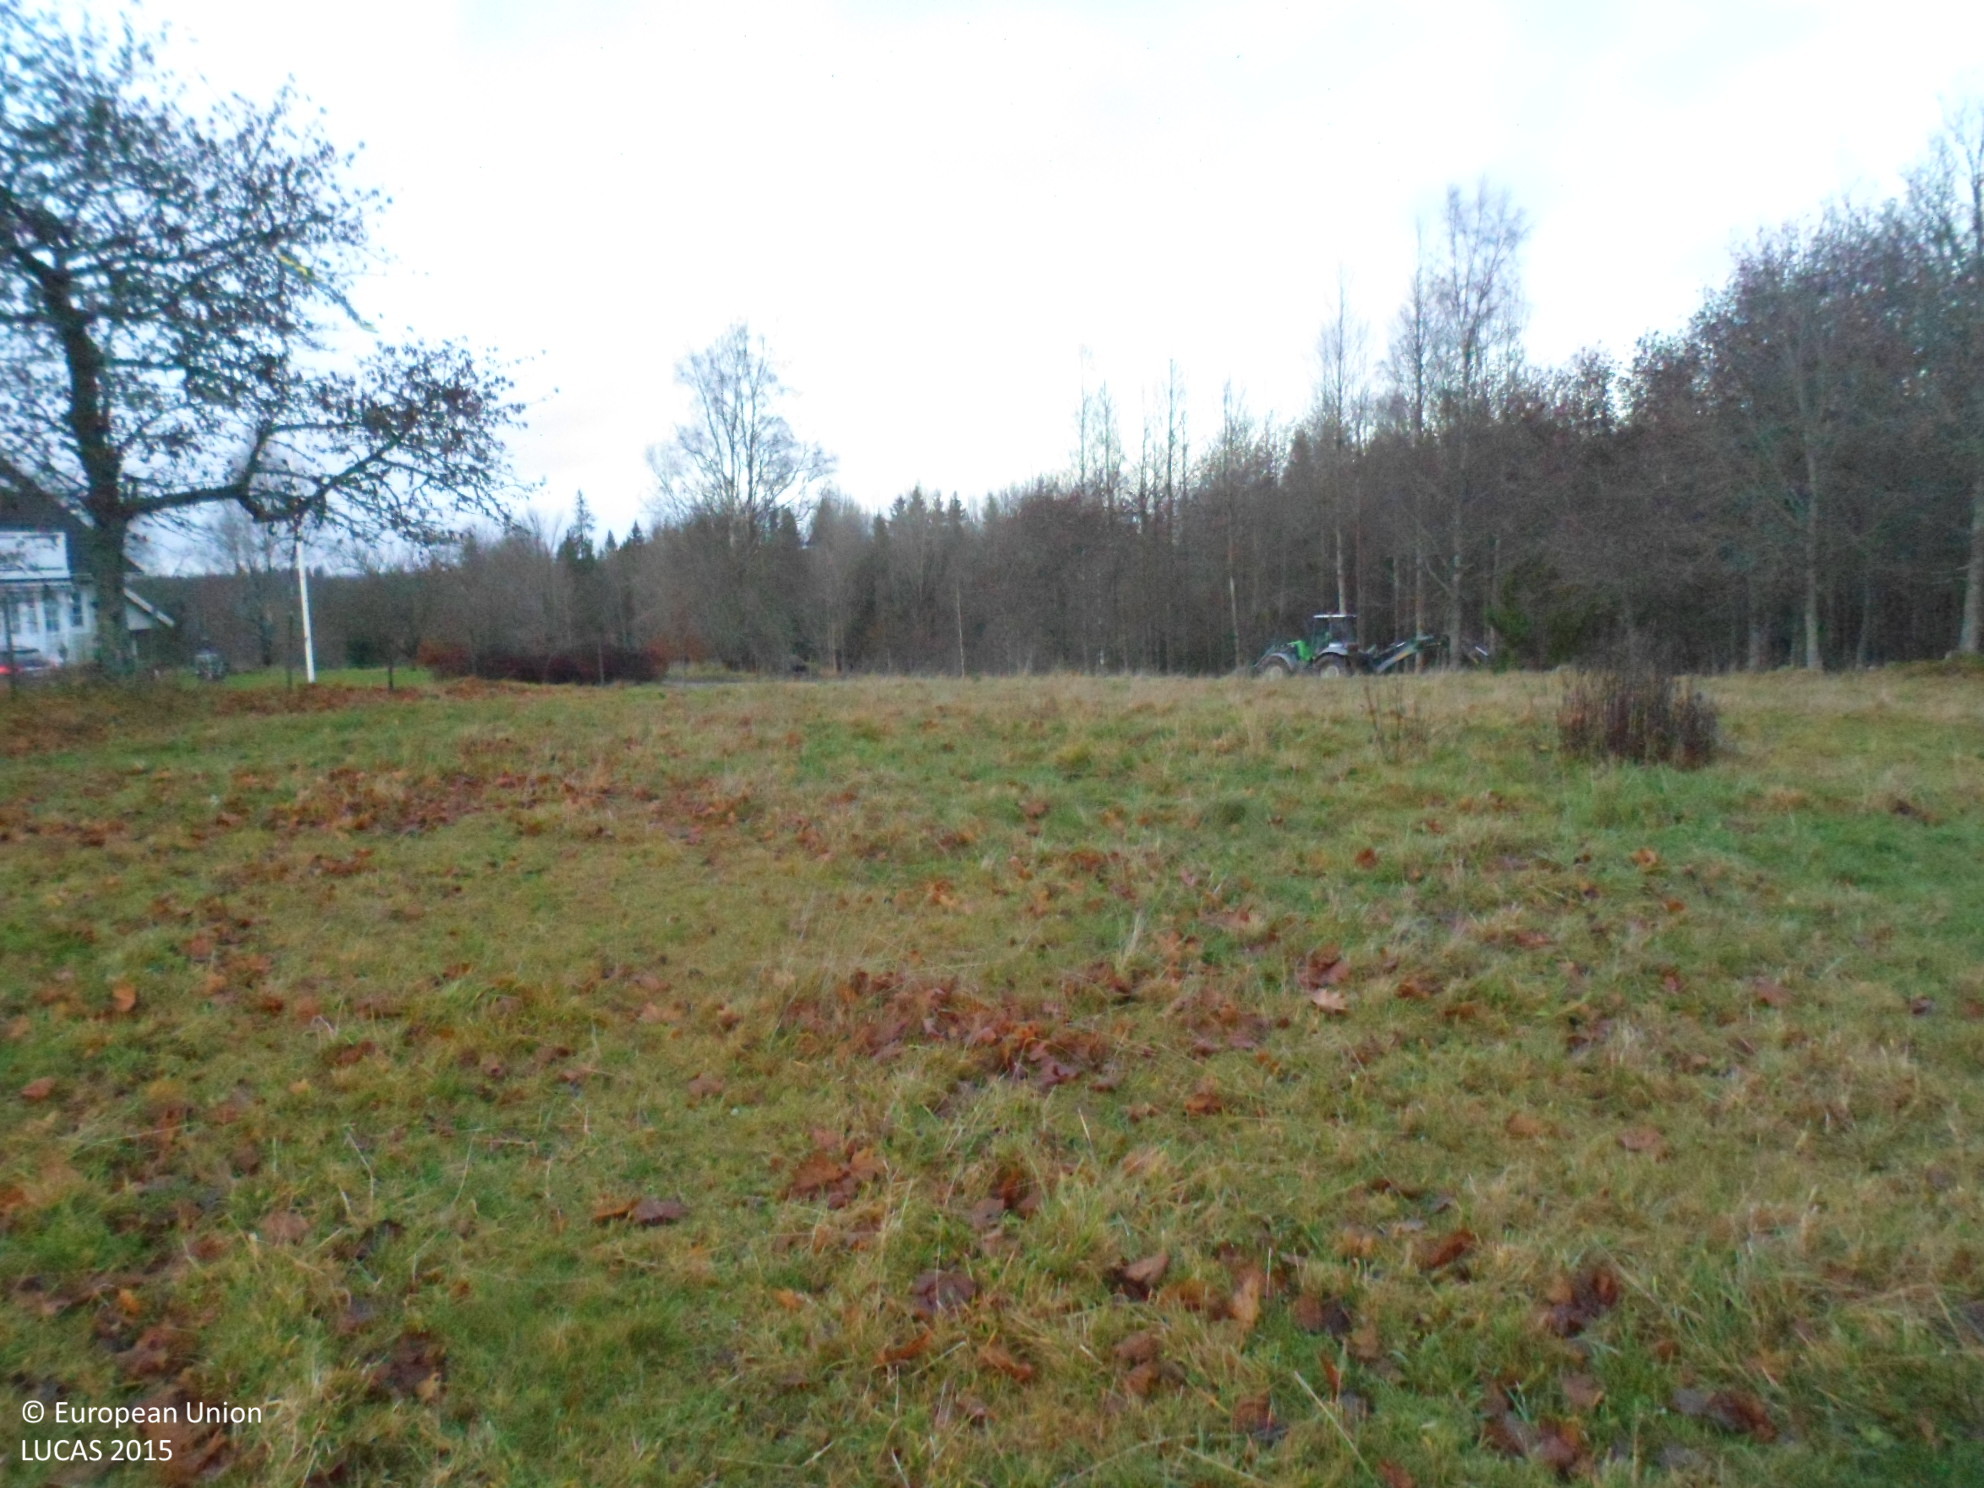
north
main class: Grassland
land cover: Grassland without tree/shrub cover
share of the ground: > 75 %
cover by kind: herbaceous plants 100 %
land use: Agriculture (excluding fallow land and kitchen gardens)
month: November
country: SE
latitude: 57.6640
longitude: 15.3098
